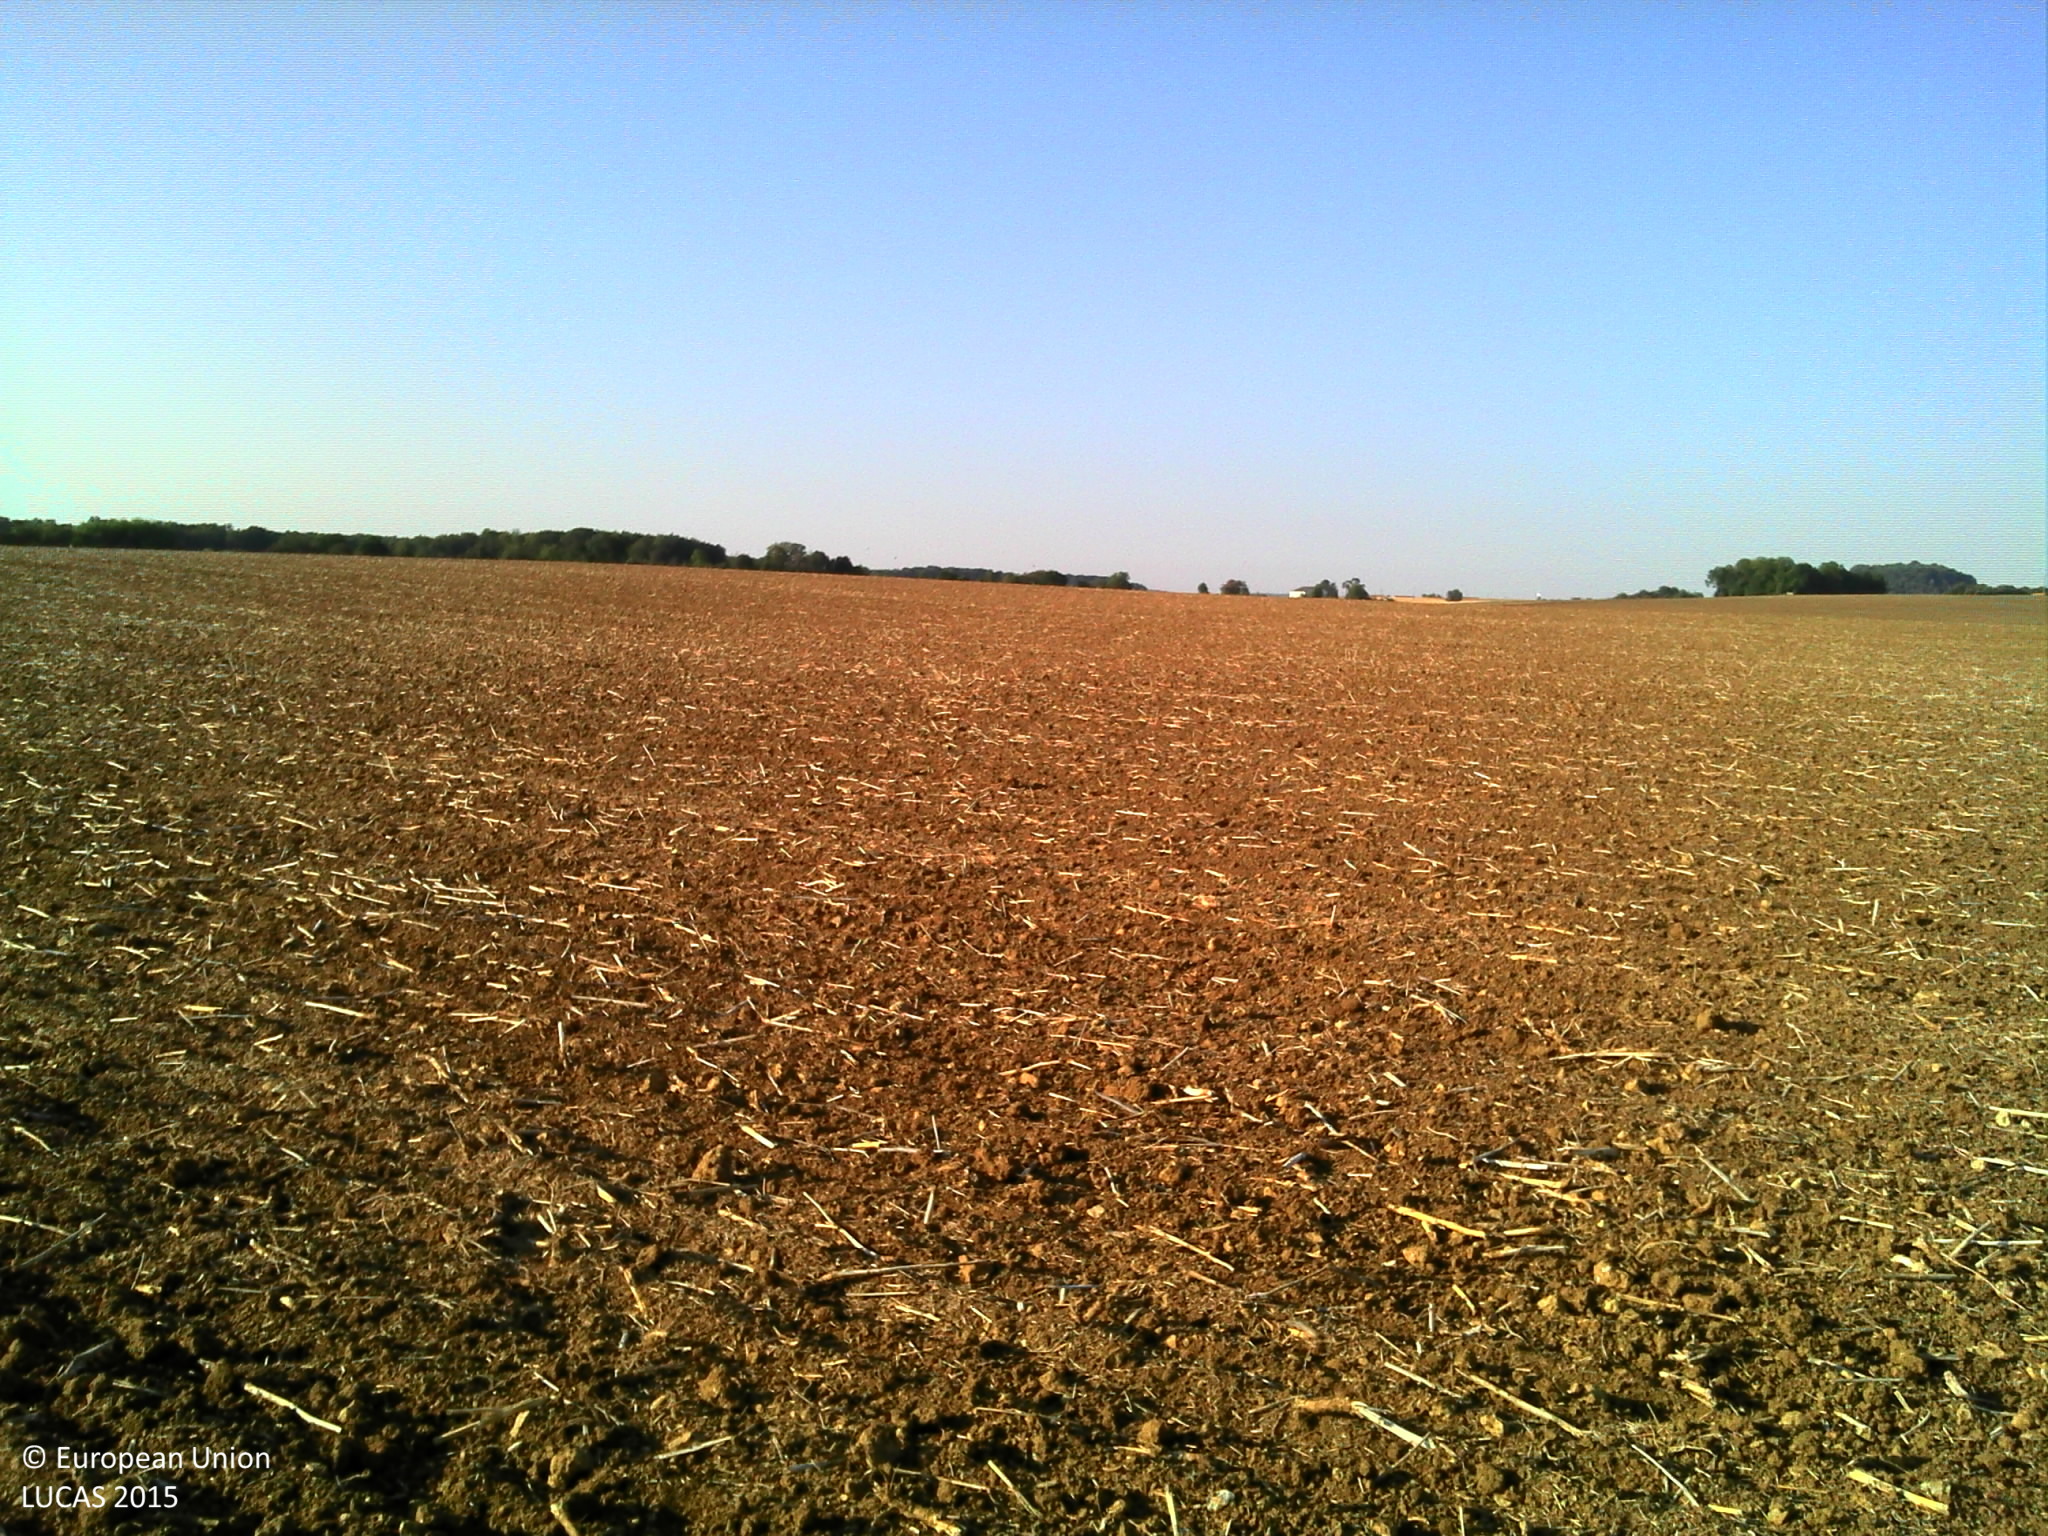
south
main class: Cropland
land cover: Rape and turnip rape
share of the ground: < 10 %
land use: Agriculture (excluding fallow land and kitchen gardens)
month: August
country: FR
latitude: 47.9125
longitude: 4.6331
